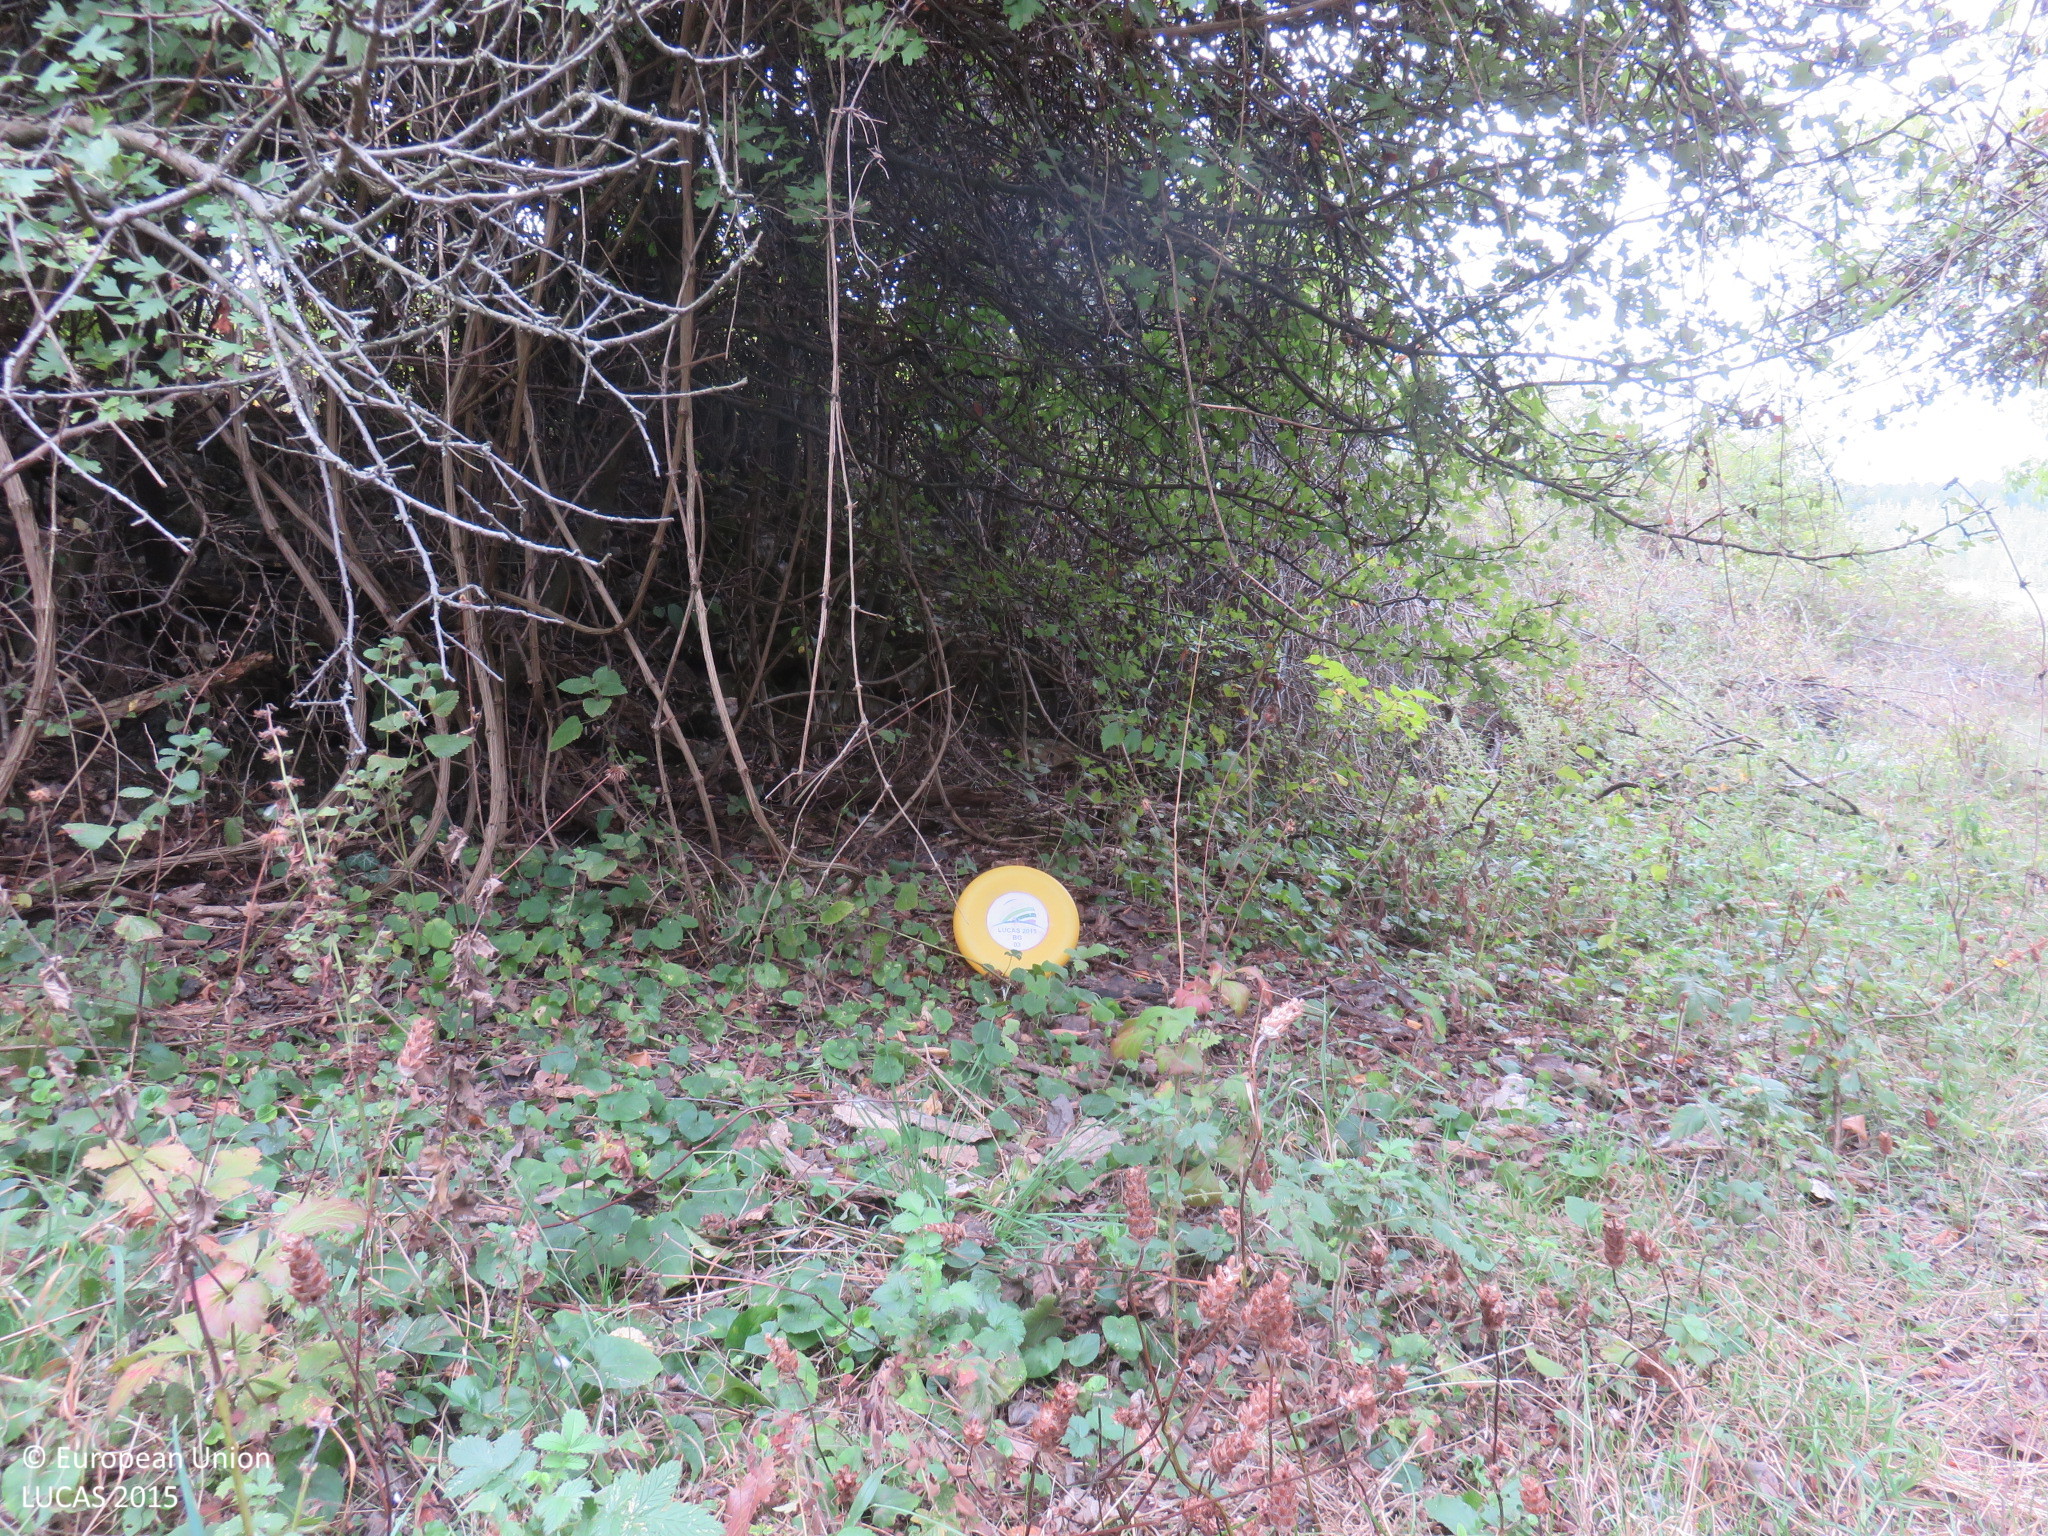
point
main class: Shrubland
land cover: Shrubland with sparse tree cover
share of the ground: > 75 %
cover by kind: shrubs 80 %, herbaceous plants 15 %, broadleaved forest trees 5 %
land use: Semi-natural and natural areas not in use
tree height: < 5 m
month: September
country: BG
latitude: 43.2129
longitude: 24.8989
